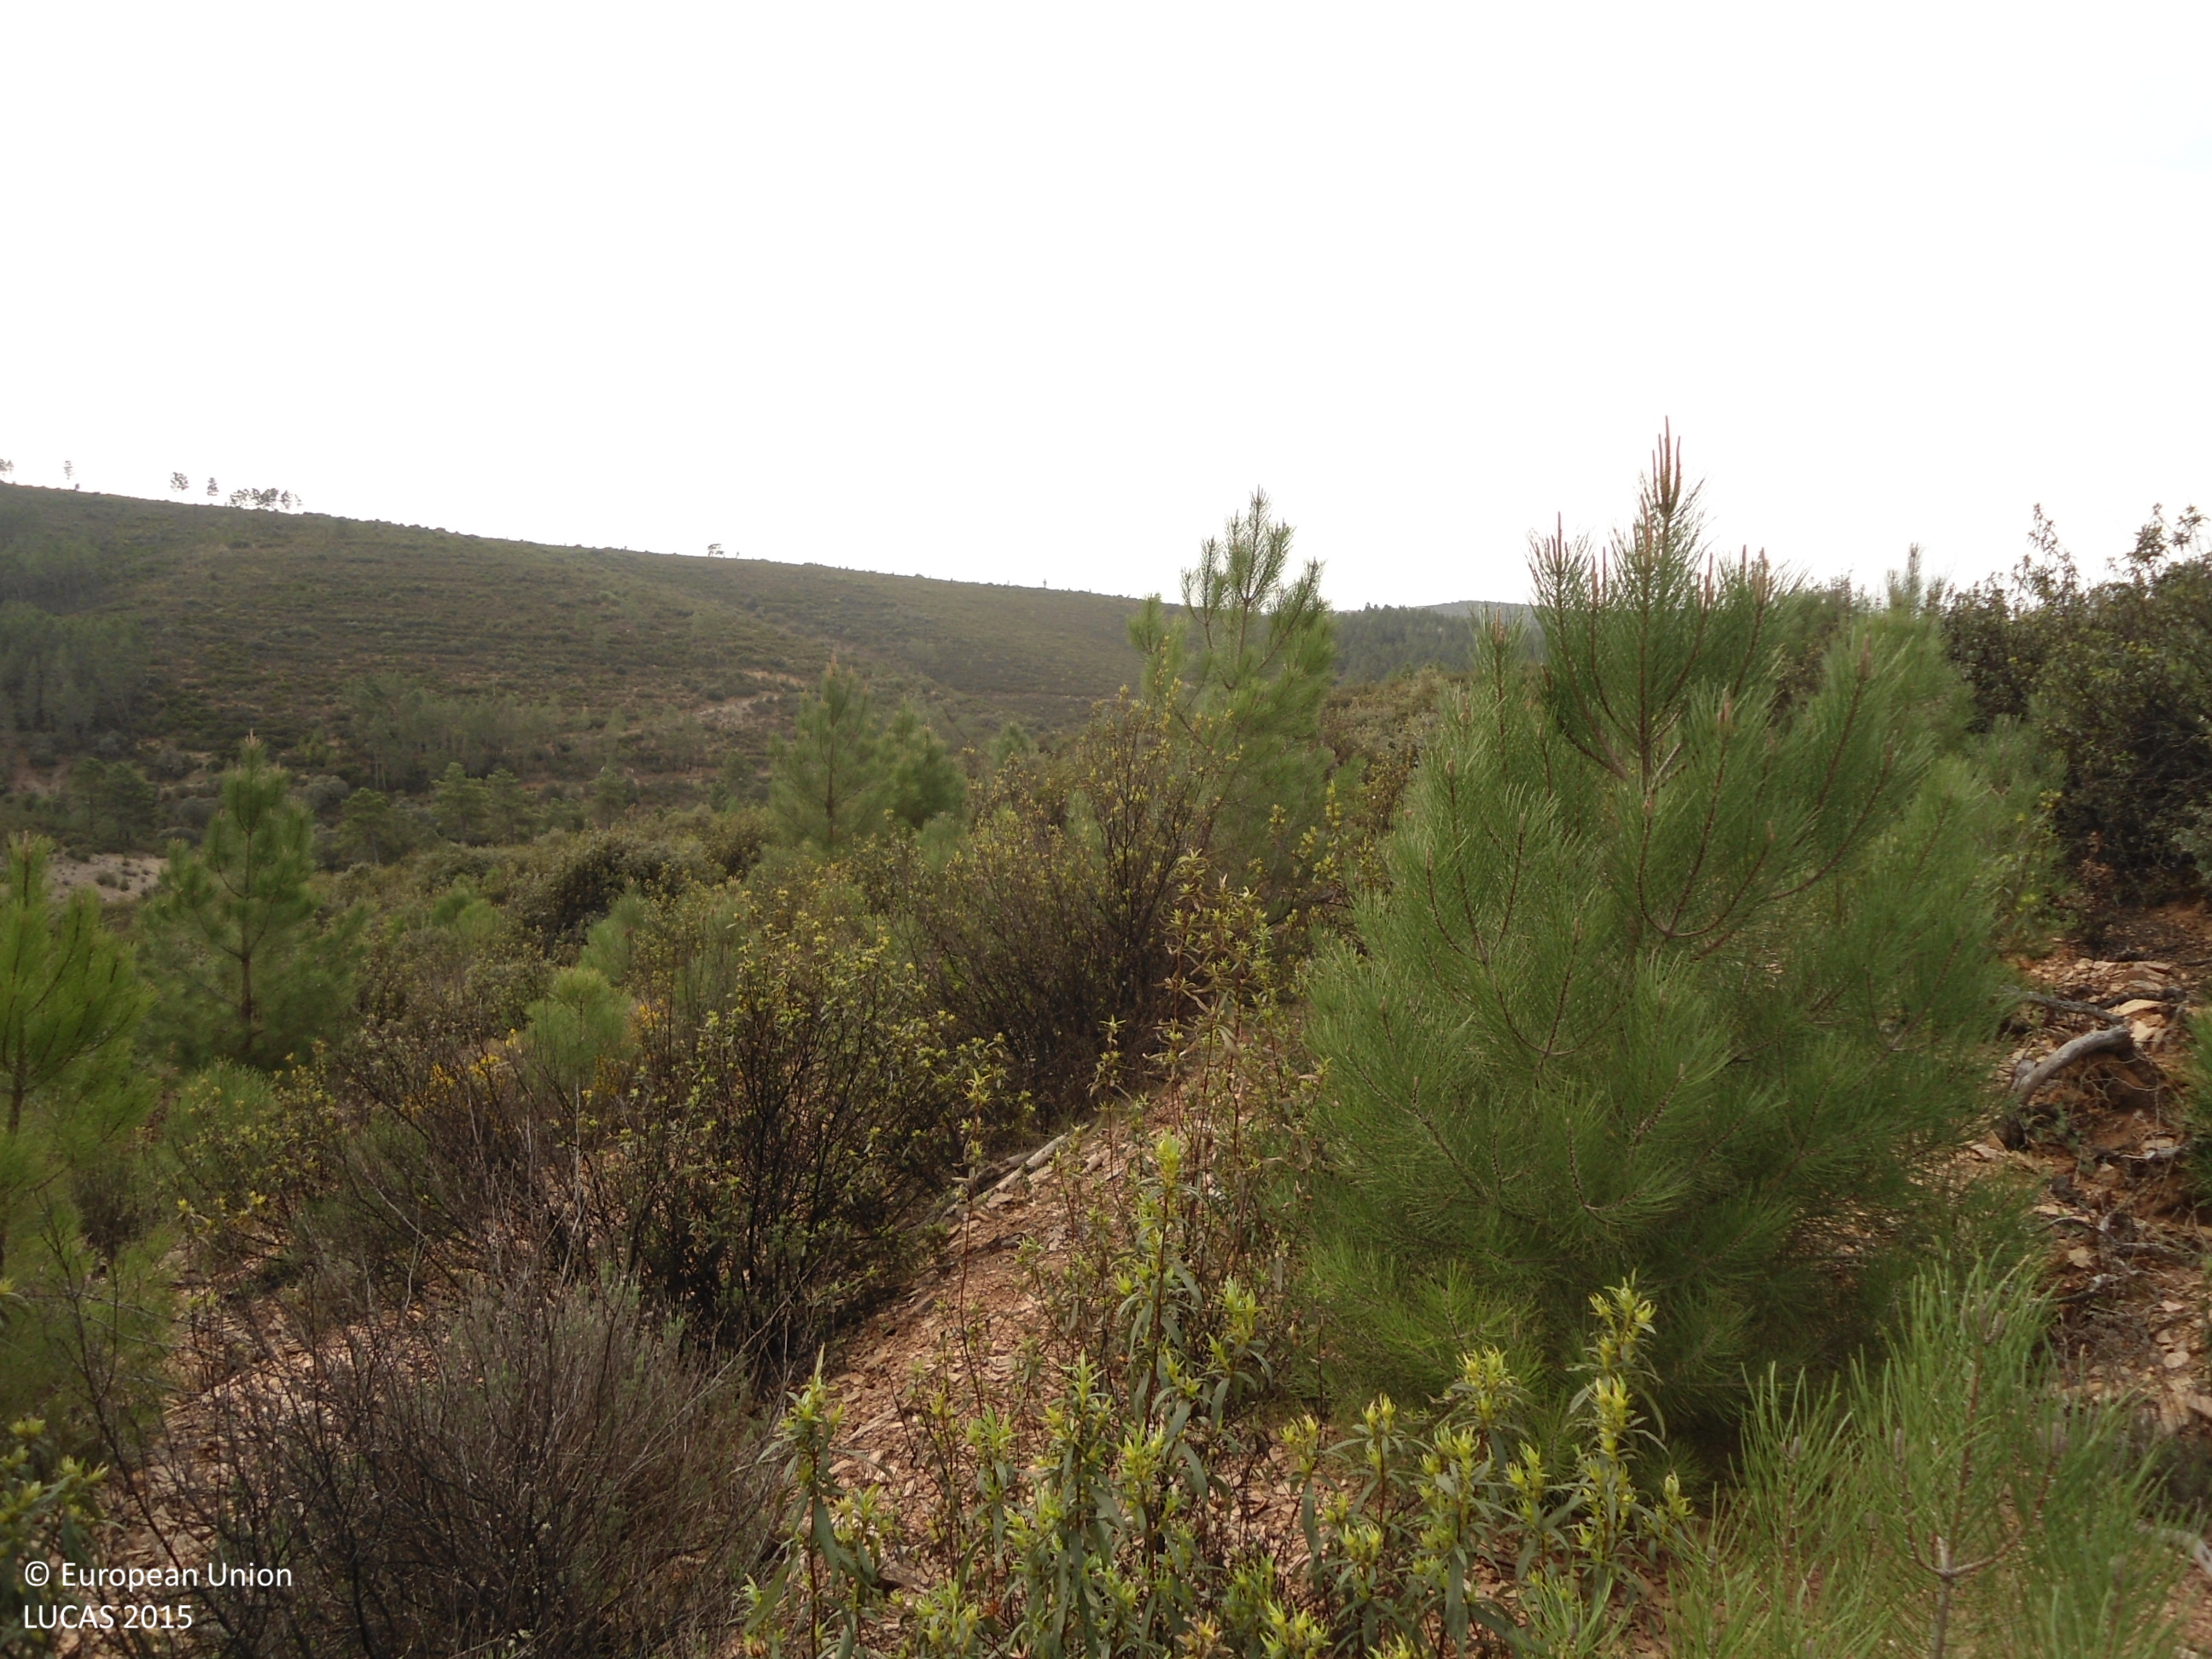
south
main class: Woodland
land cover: Pine dominated coniferous woodland
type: coniferous forest of the mediterranean region
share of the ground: 50 - 75 %
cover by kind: coniferous forest trees 50 %, shrubs 50 %
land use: Forestry
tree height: < 5 m
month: April
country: ES
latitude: 41.8029
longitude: -6.5120
